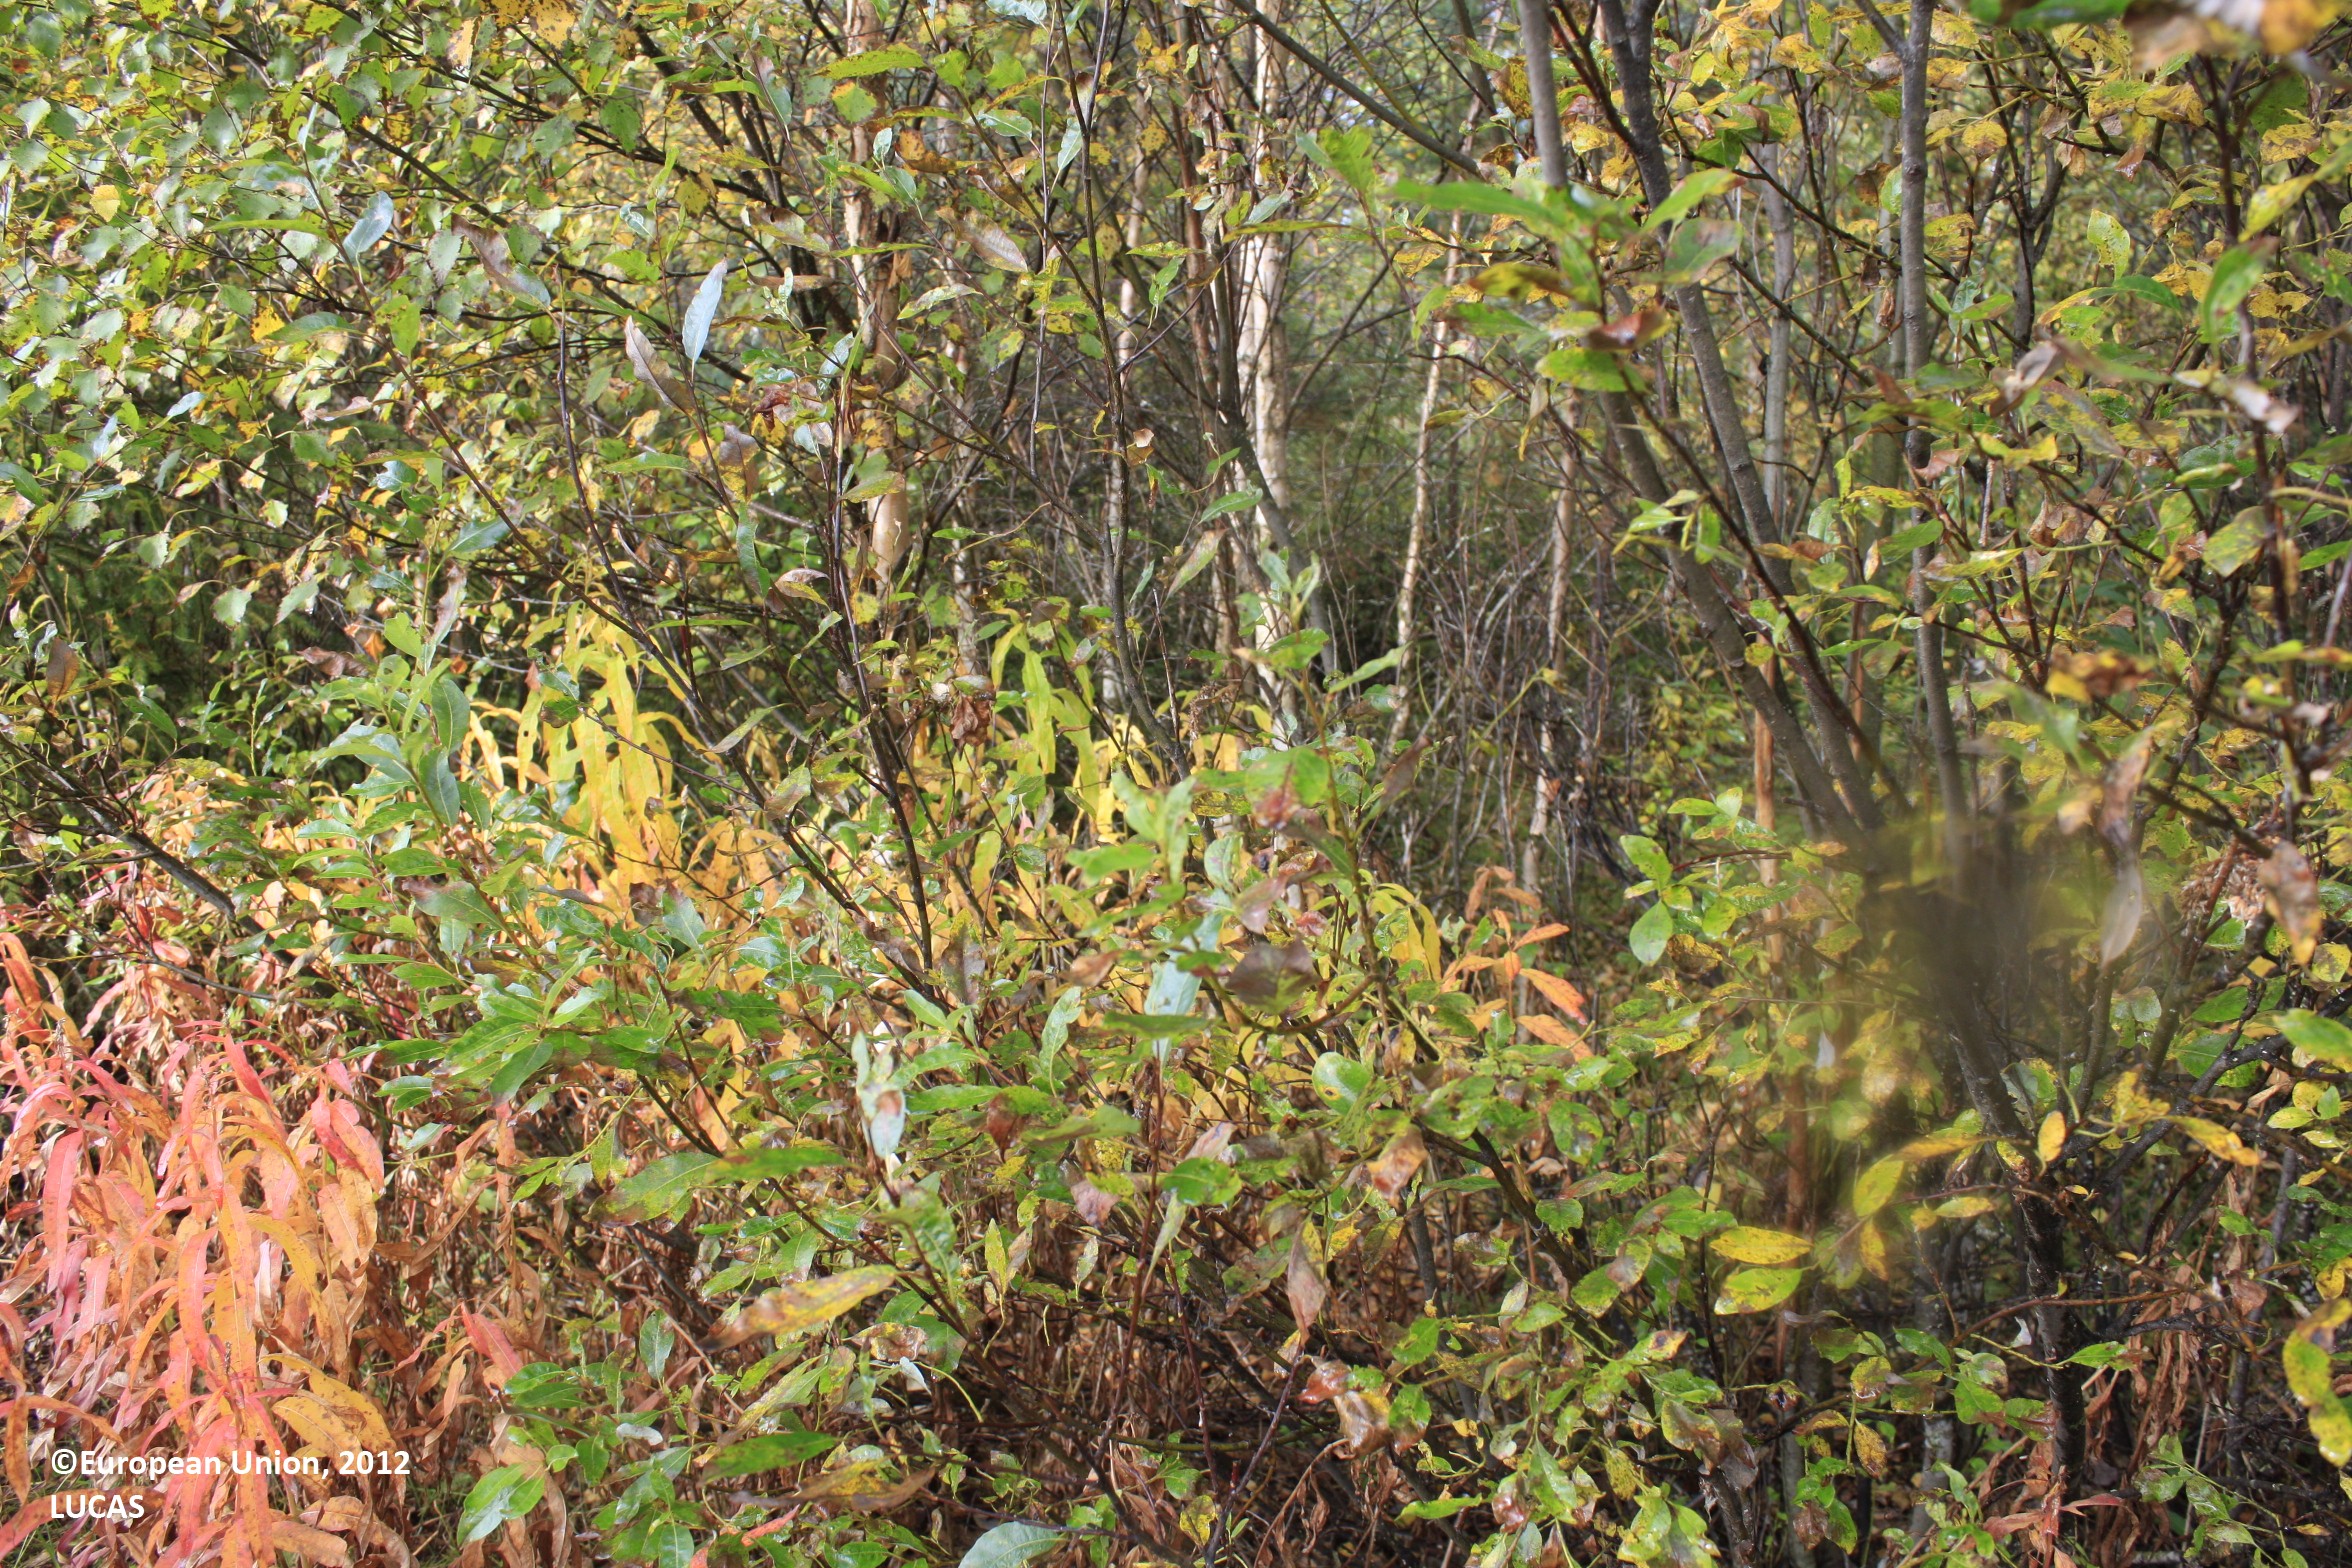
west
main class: Shrubland
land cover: Shrubland with sparse tree cover
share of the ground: > 75 %
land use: Semi-natural and natural areas not in use
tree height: > 5 m
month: September
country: FI
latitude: 65.5755
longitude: 26.5966
